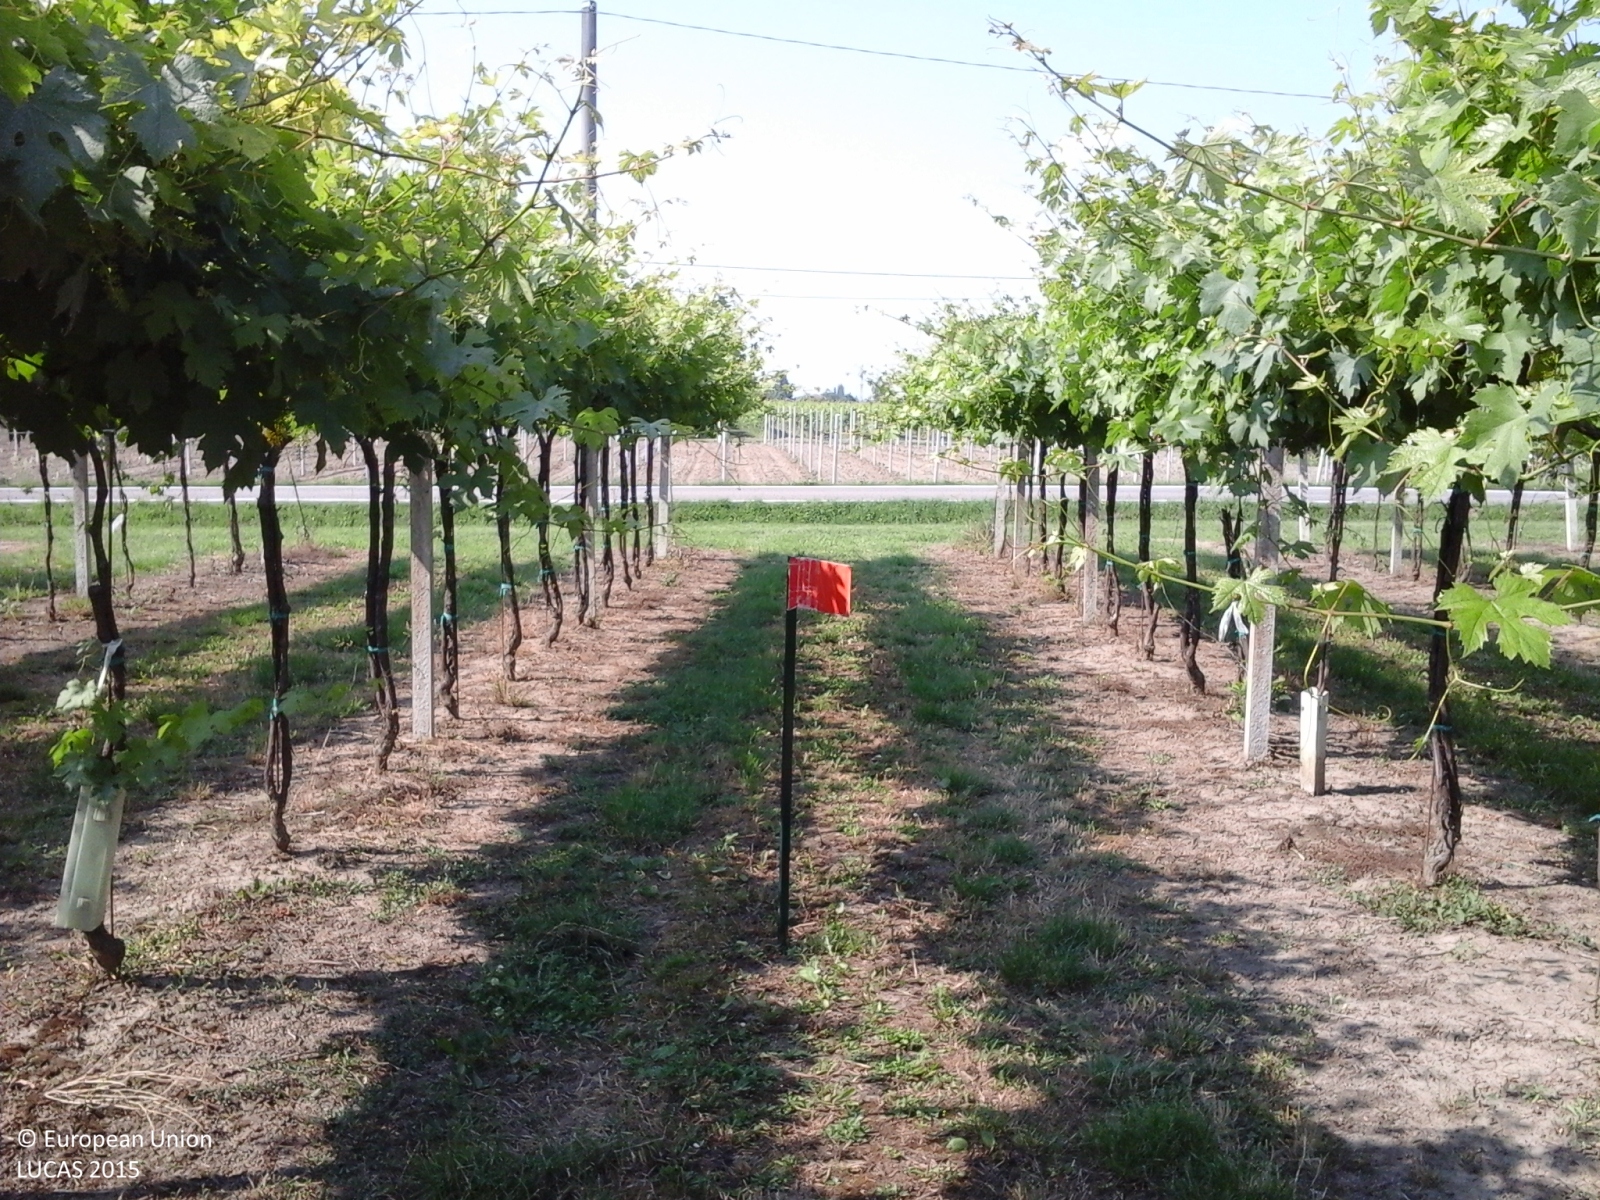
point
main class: Cropland
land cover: Vineyards
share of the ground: 25 - 50 %
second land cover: Grassland without tree/shrub cover
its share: 50 - 75 %
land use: Agriculture (excluding fallow land and kitchen gardens)
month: May
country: IT
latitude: 44.7627
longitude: 10.7439
